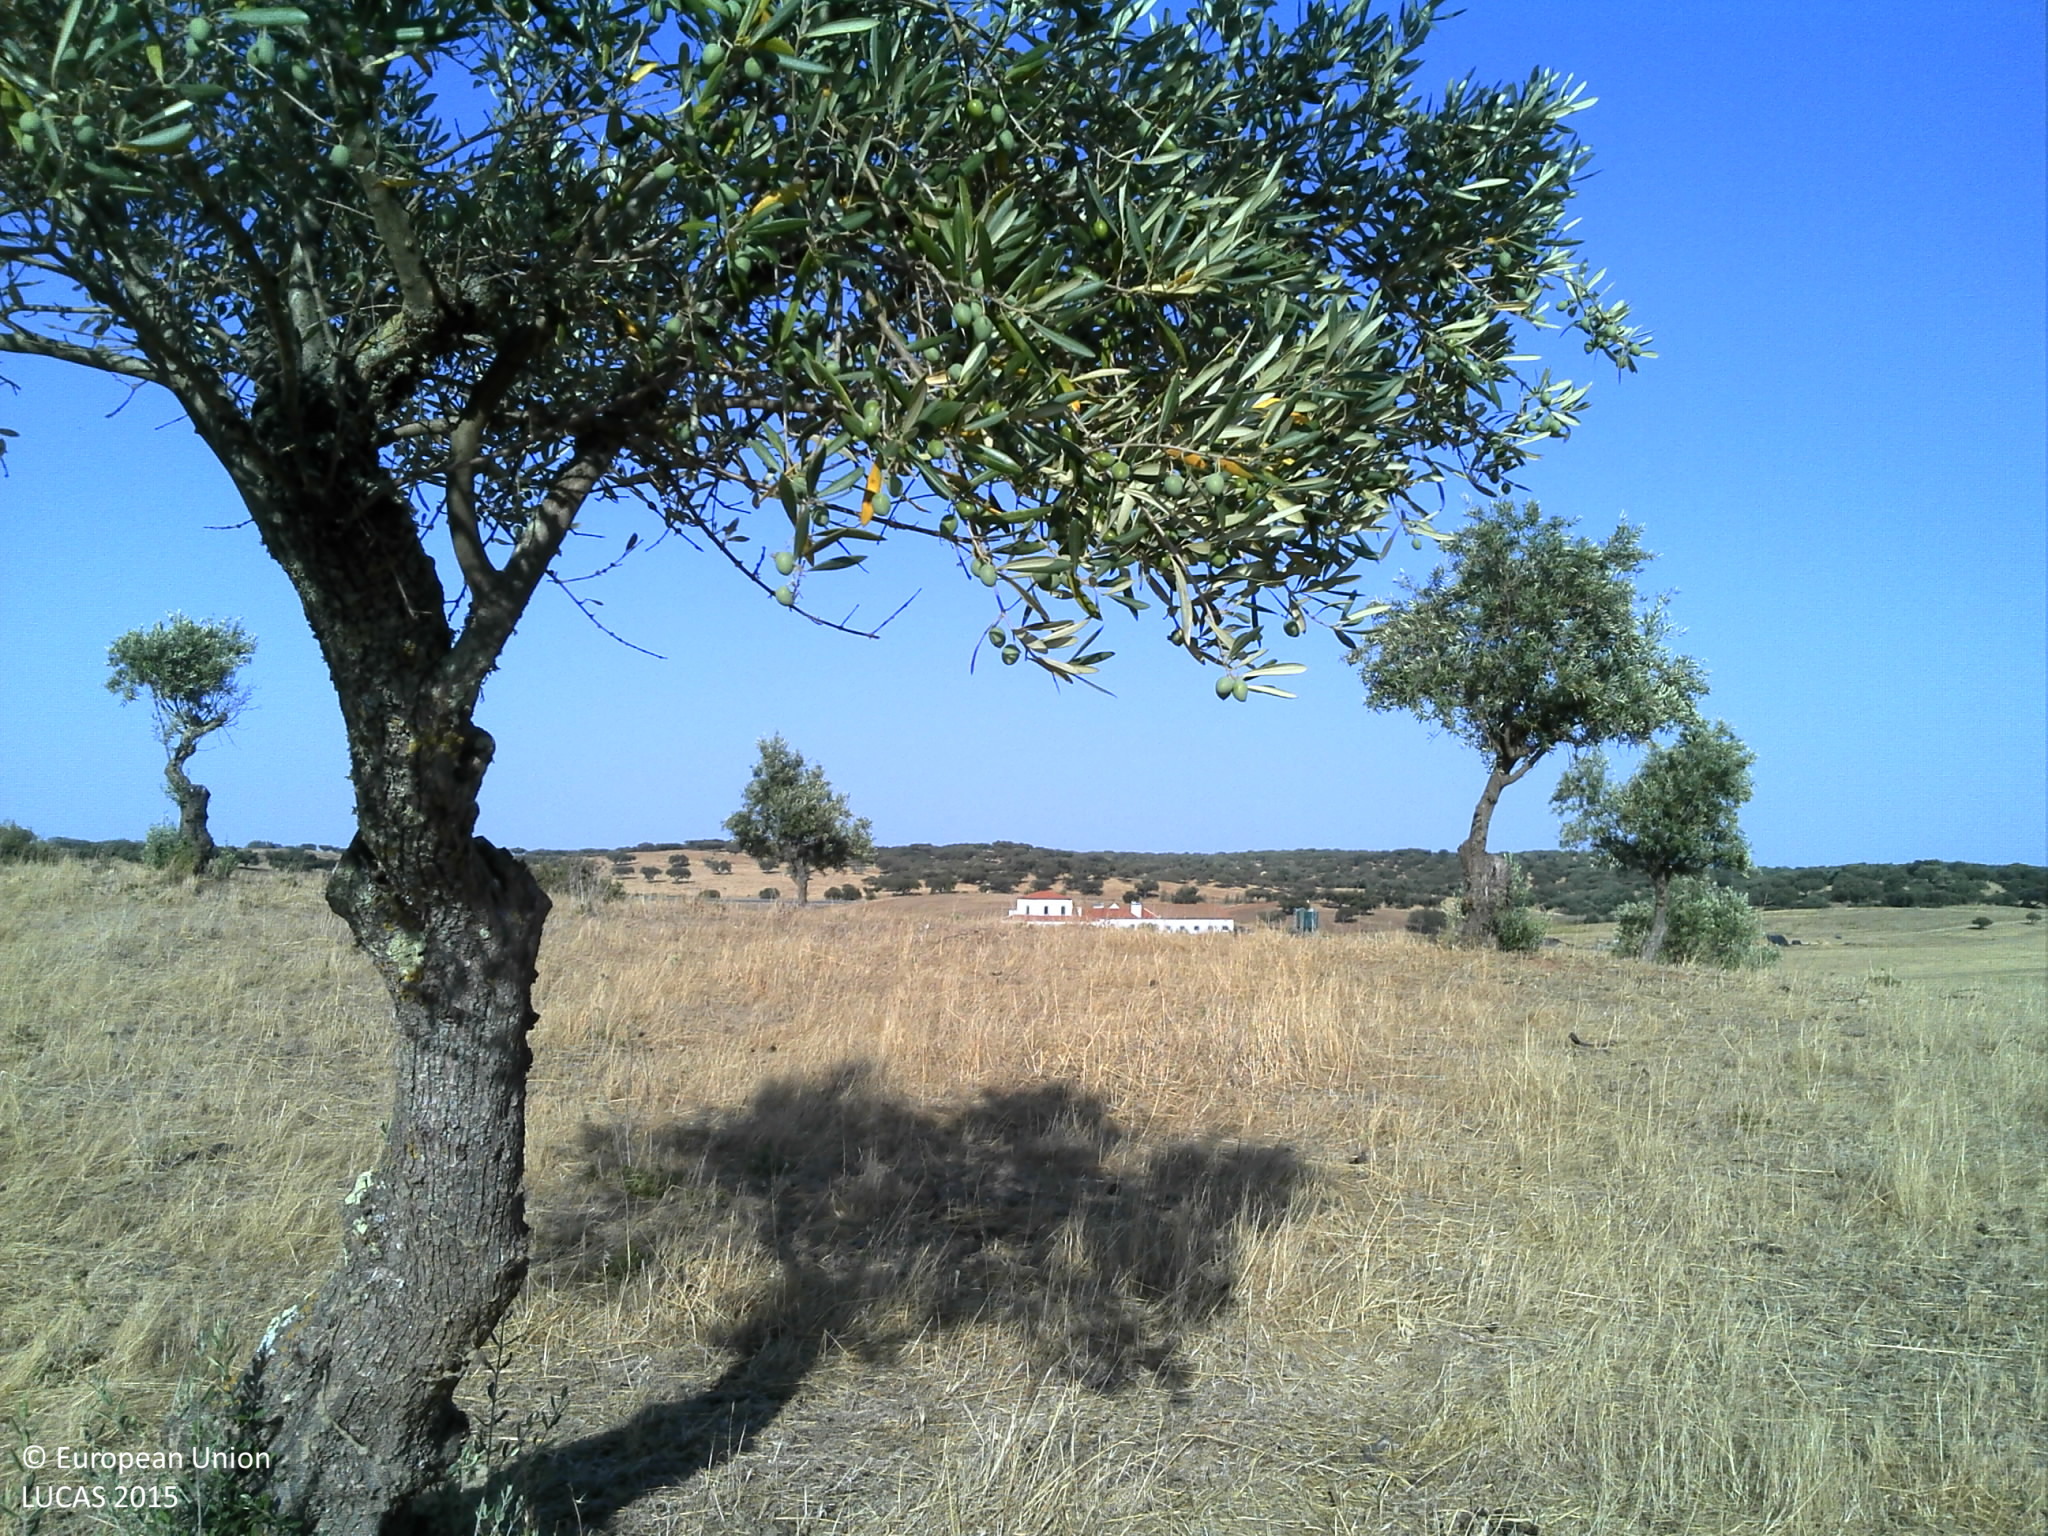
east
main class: Cropland
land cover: Olive groves
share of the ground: 10 - 25 %
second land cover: Grassland without tree/shrub cover
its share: 10 - 25 %
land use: Agriculture (excluding fallow land and kitchen gardens)
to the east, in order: Olive groves; Grassland without tree/shrub cover; Olive groves; Broadleaved woodland; Fences; Inland fresh running water; Broadleaved woodland; Olive groves; Fences; Olive groves
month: July
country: PT
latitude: 38.3814
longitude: -7.7179
